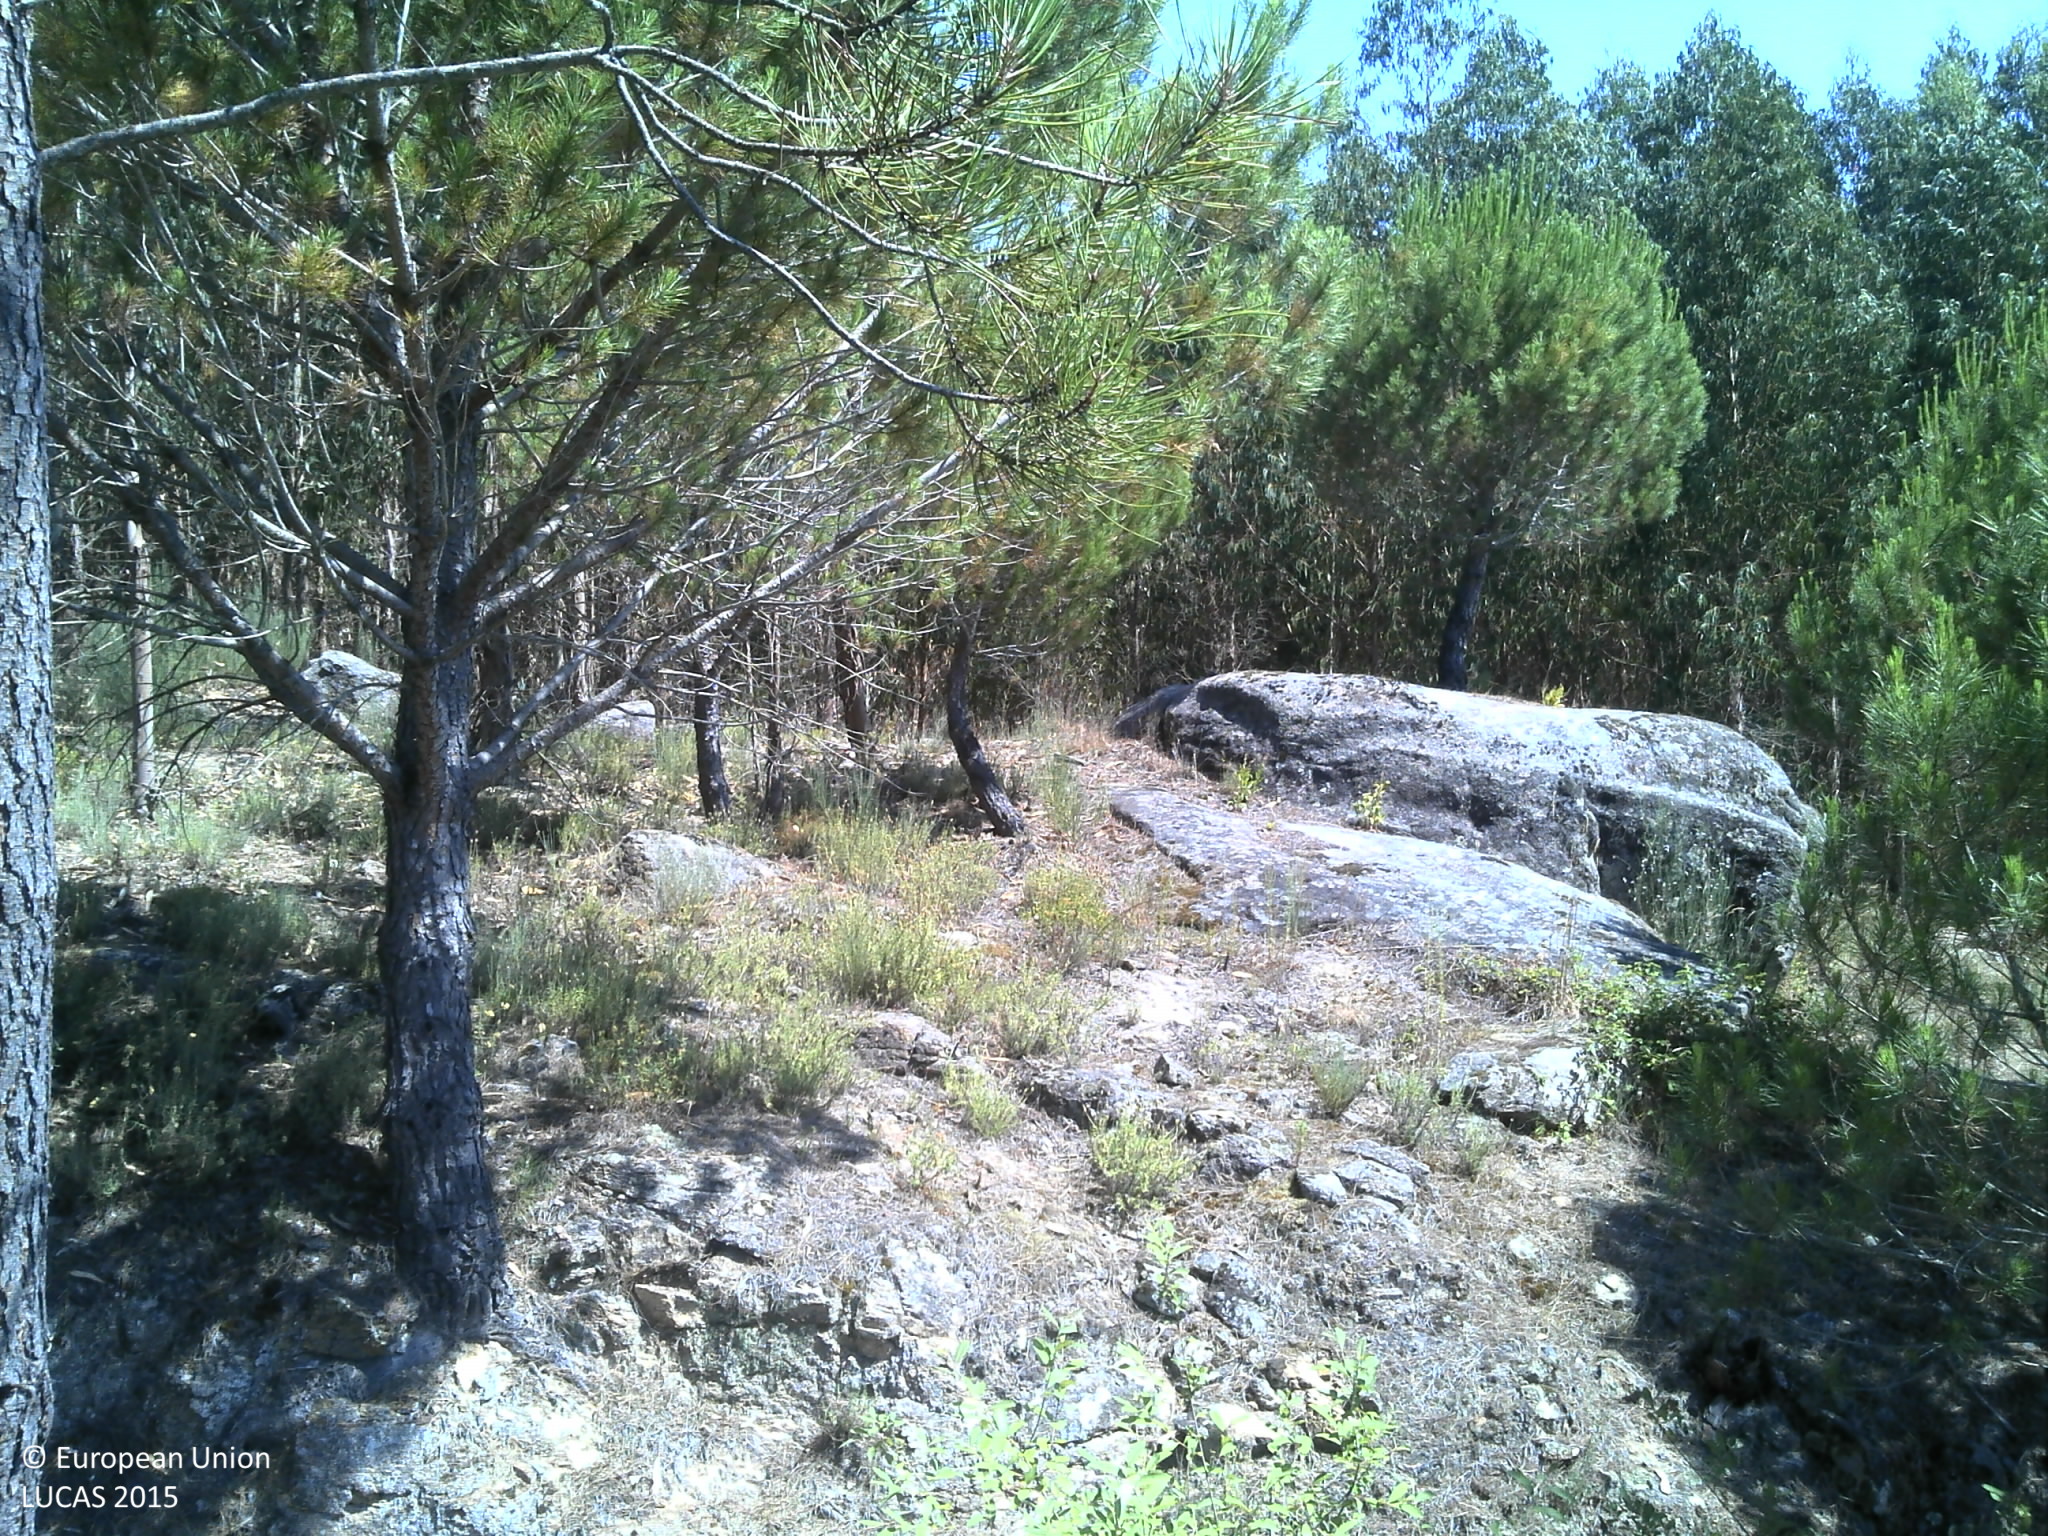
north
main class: Woodland
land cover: Pine dominated coniferous woodland
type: coniferous forest of the mediterranean region
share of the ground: 25 - 50 %
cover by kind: coniferous forest trees 45 %, herbaceous plants 25 %, shrubs 10 %, consolidated bare surface 10 %, unconsolidated bare surface 10 %
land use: Forestry
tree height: > 5 m
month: June
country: PT
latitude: 40.5329
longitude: -7.7677
